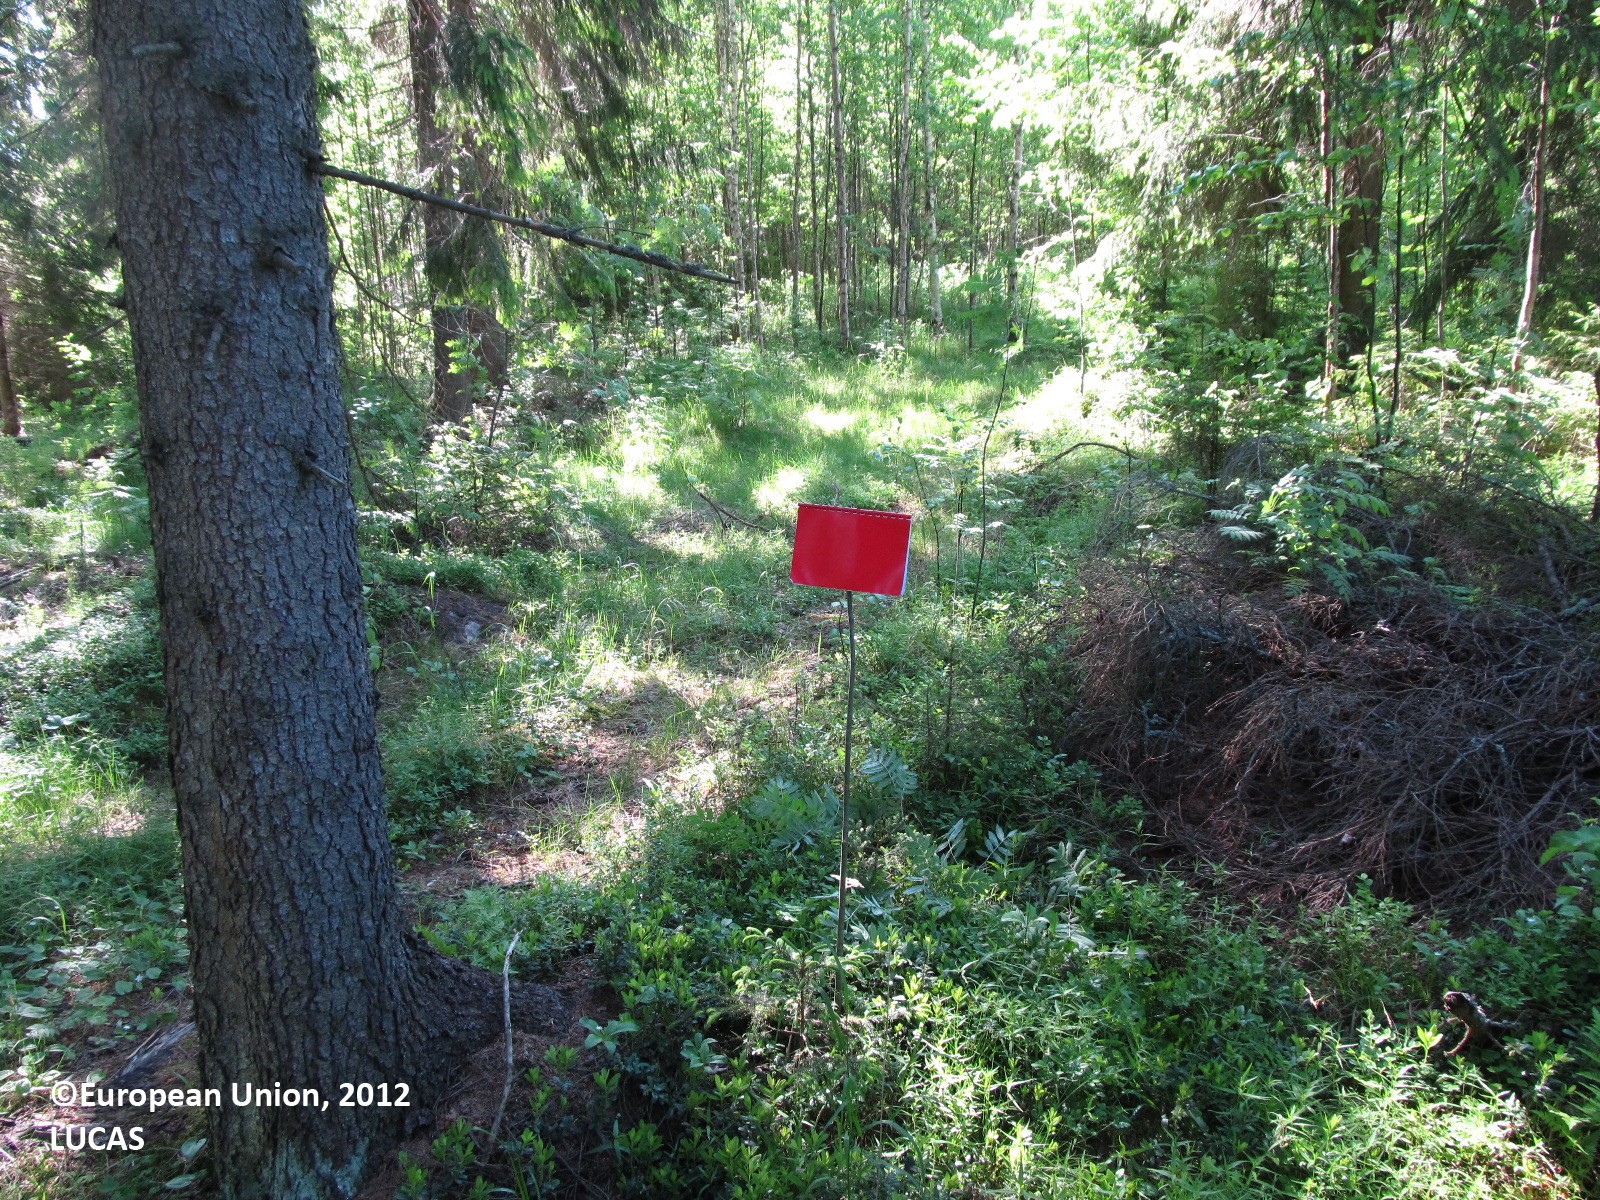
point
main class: Woodland
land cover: Spruce dominated coniferous woodland
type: boreal forest
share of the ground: 50 - 75 %
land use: Forestry
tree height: > 5 m
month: June
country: FI
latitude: 62.6801
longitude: 27.5691
